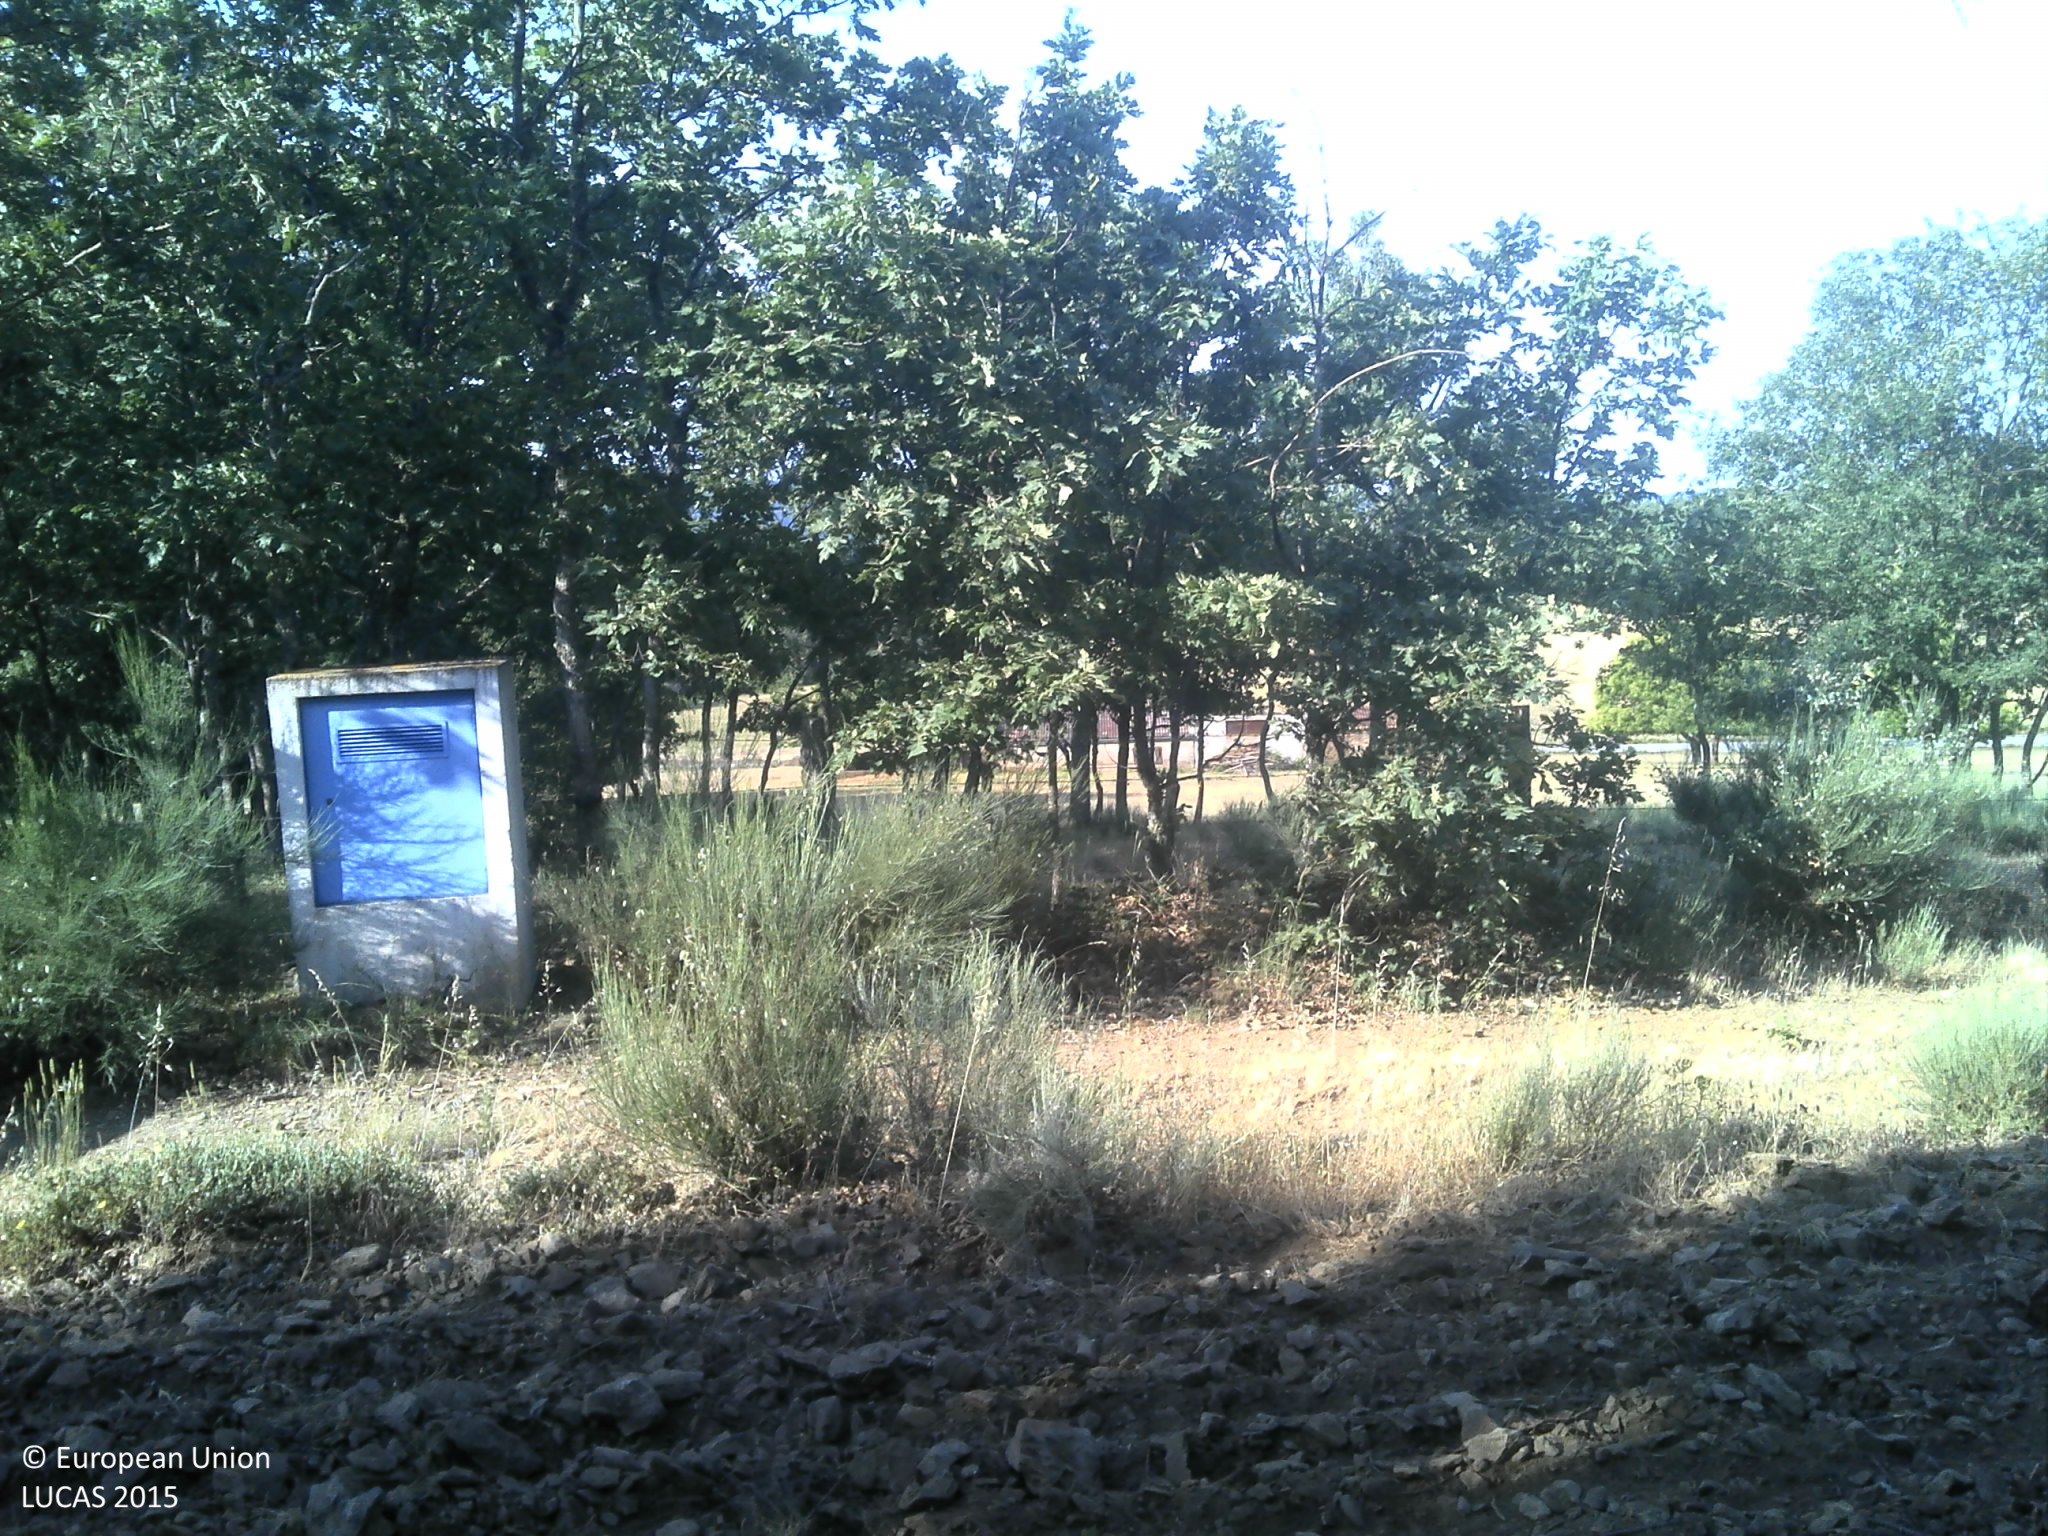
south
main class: Woodland
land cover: Pine dominated coniferous woodland
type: coniferous forest of the mediterranean region
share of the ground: 50 - 75 %
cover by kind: coniferous forest trees 65 %, unconsolidated bare surface 30 %, shrubs 5 %
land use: Forestry
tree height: > 5 m
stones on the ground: 10 - 25 %
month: June
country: PT
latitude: 40.3365
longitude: -7.0117
